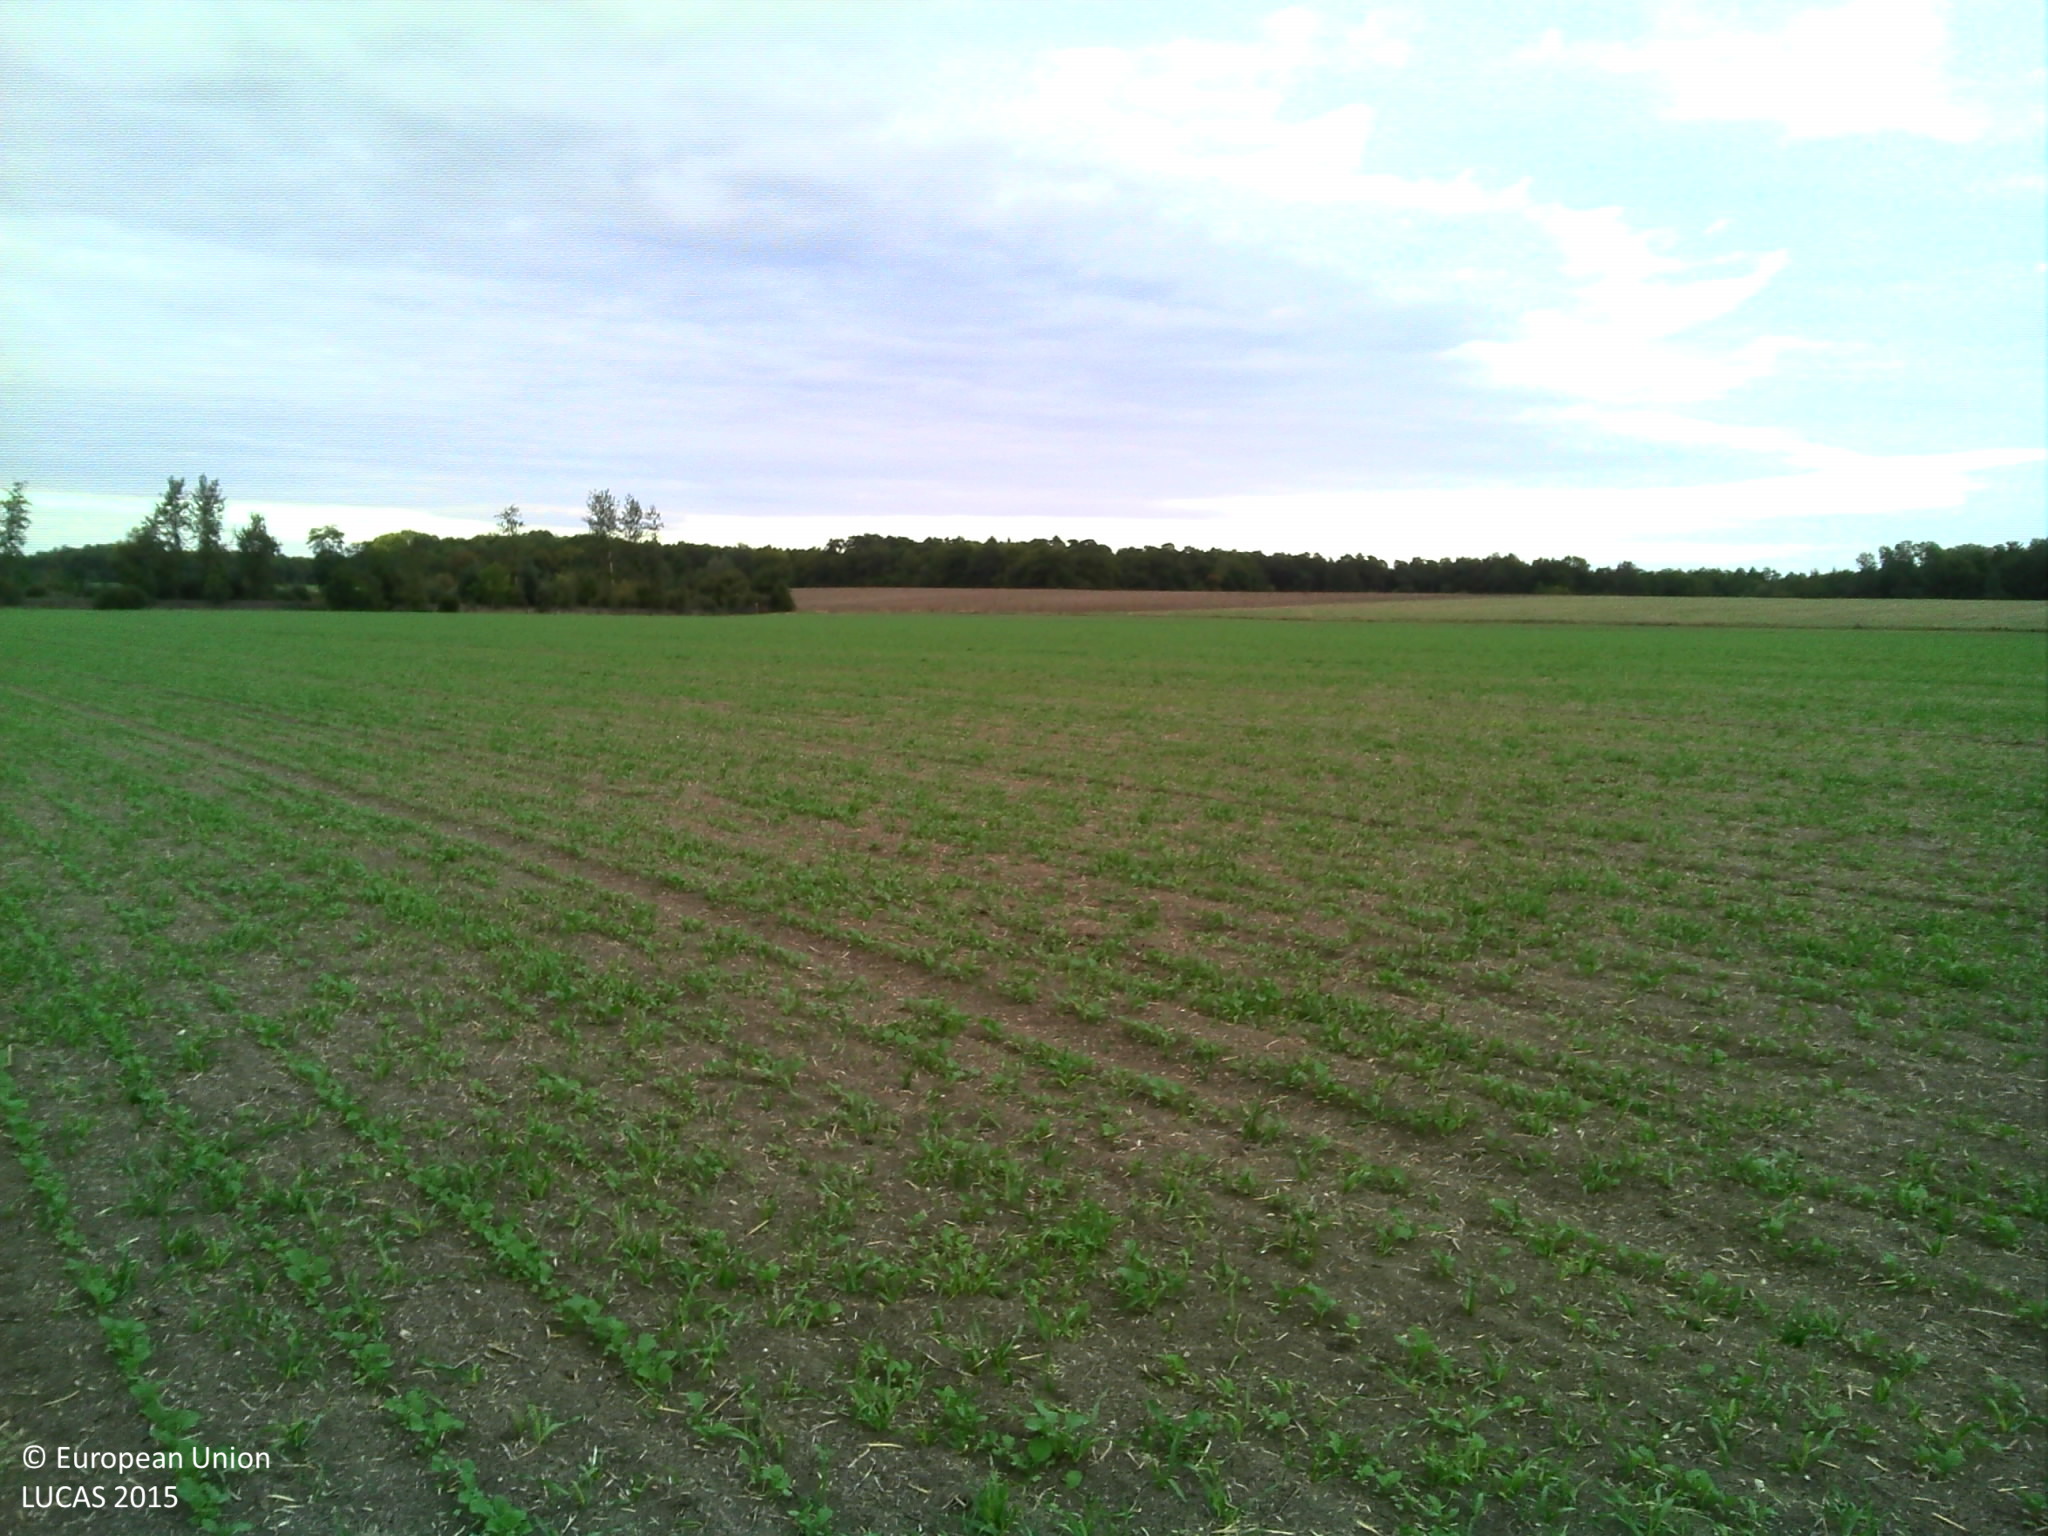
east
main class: Cropland
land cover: Rape and turnip rape
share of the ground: 50 - 75 %
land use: Agriculture (excluding fallow land and kitchen gardens)
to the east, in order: Rape and turnip rape
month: September
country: FR
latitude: 48.3268
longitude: 4.2645
